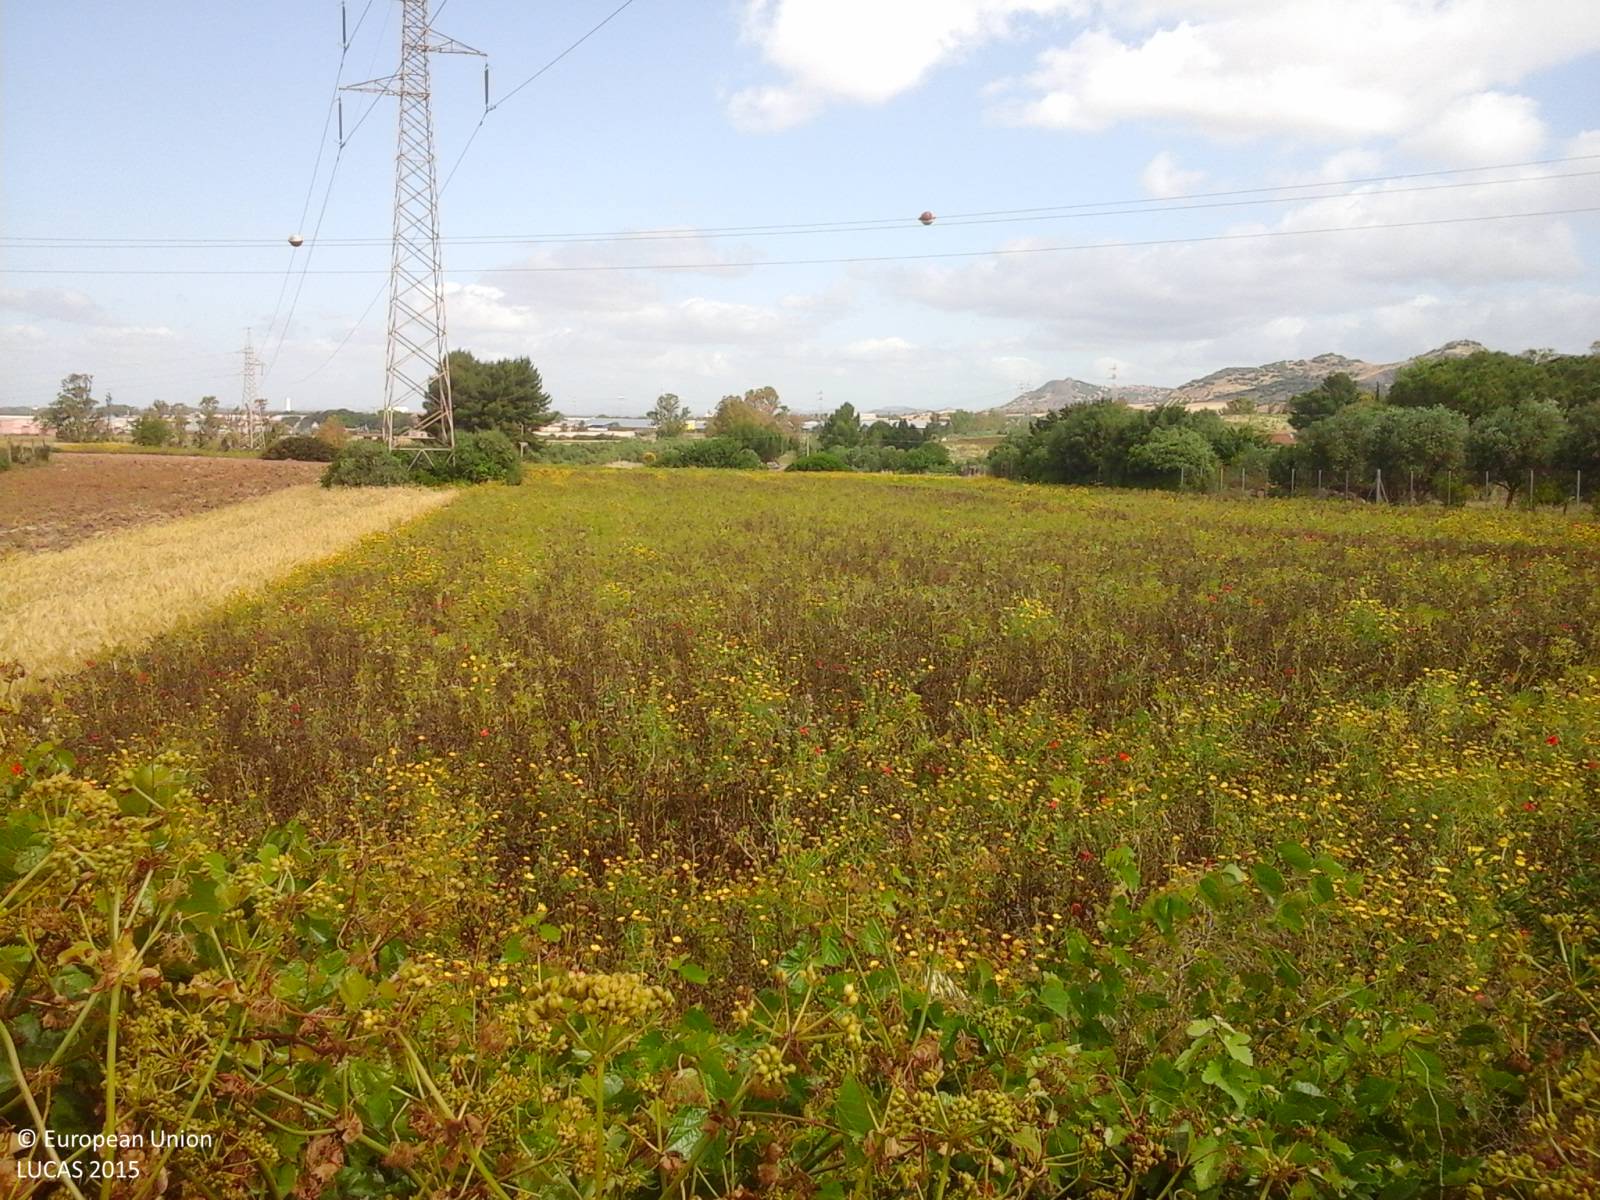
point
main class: Grassland
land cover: Spontaneously vegetated surfaces
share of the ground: > 75 %
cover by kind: herbaceous plants 100 %
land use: Agriculture (excluding fallow land and kitchen gardens)
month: May
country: IT
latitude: 39.3392
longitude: 9.0659
